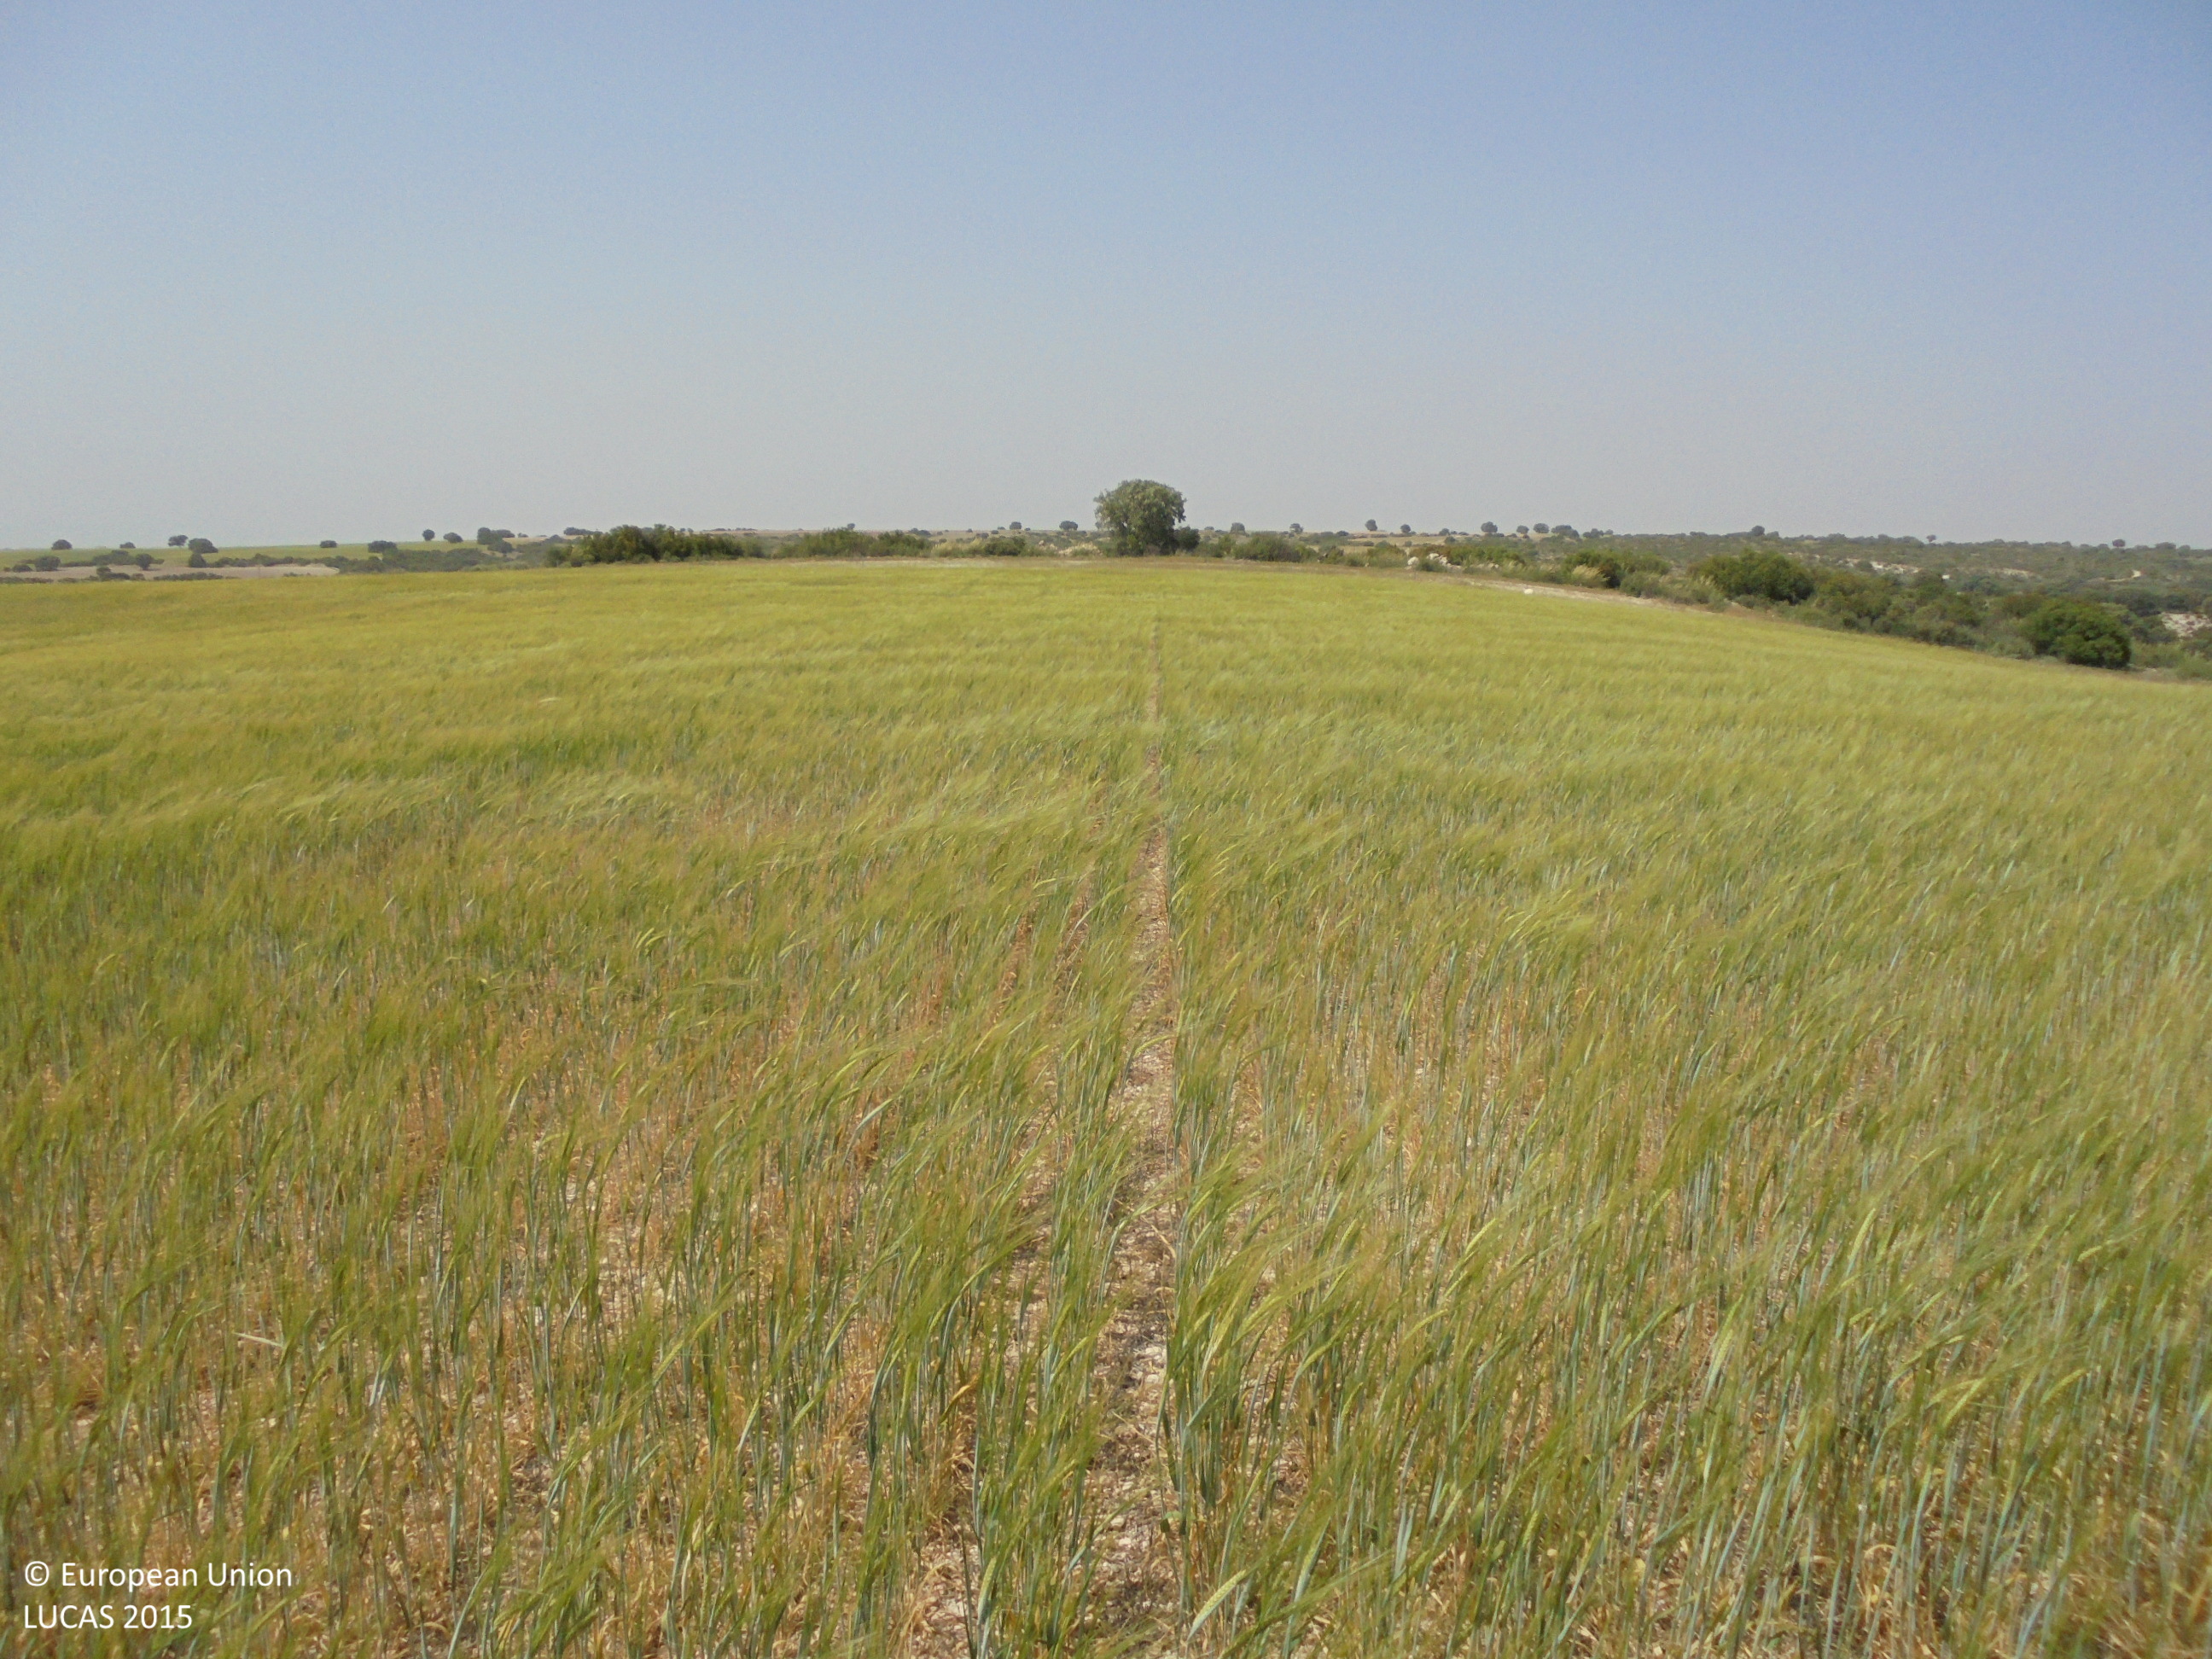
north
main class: Cropland
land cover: Barley
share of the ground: 50 - 75 %
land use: Agriculture (excluding fallow land and kitchen gardens)
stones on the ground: > 50 %
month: May
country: ES
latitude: 39.0704
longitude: -1.7087
